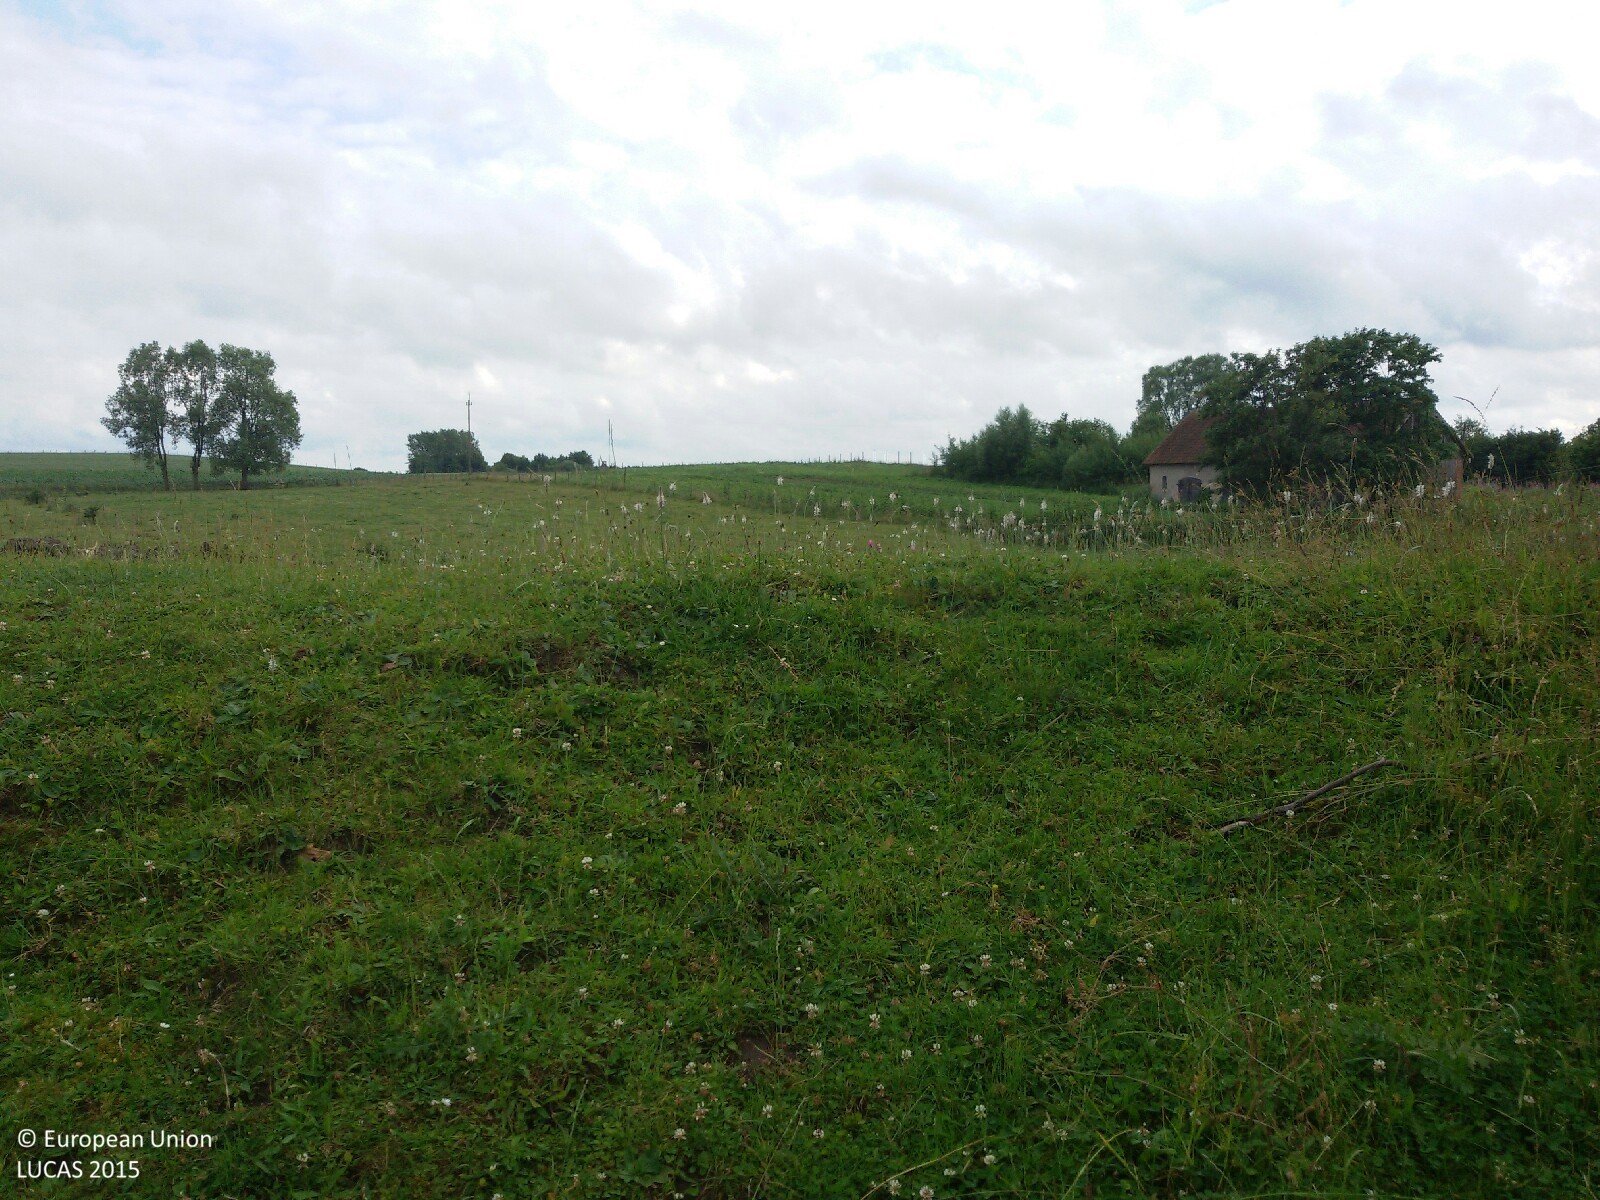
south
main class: Grassland
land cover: Grassland without tree/shrub cover
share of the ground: > 75 %
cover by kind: herbaceous plants 90 %, shrubs 5 %, unconsolidated bare surface 5 %
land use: Agriculture (excluding fallow land and kitchen gardens)
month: July
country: PL
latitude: 54.0863
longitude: 20.2918
